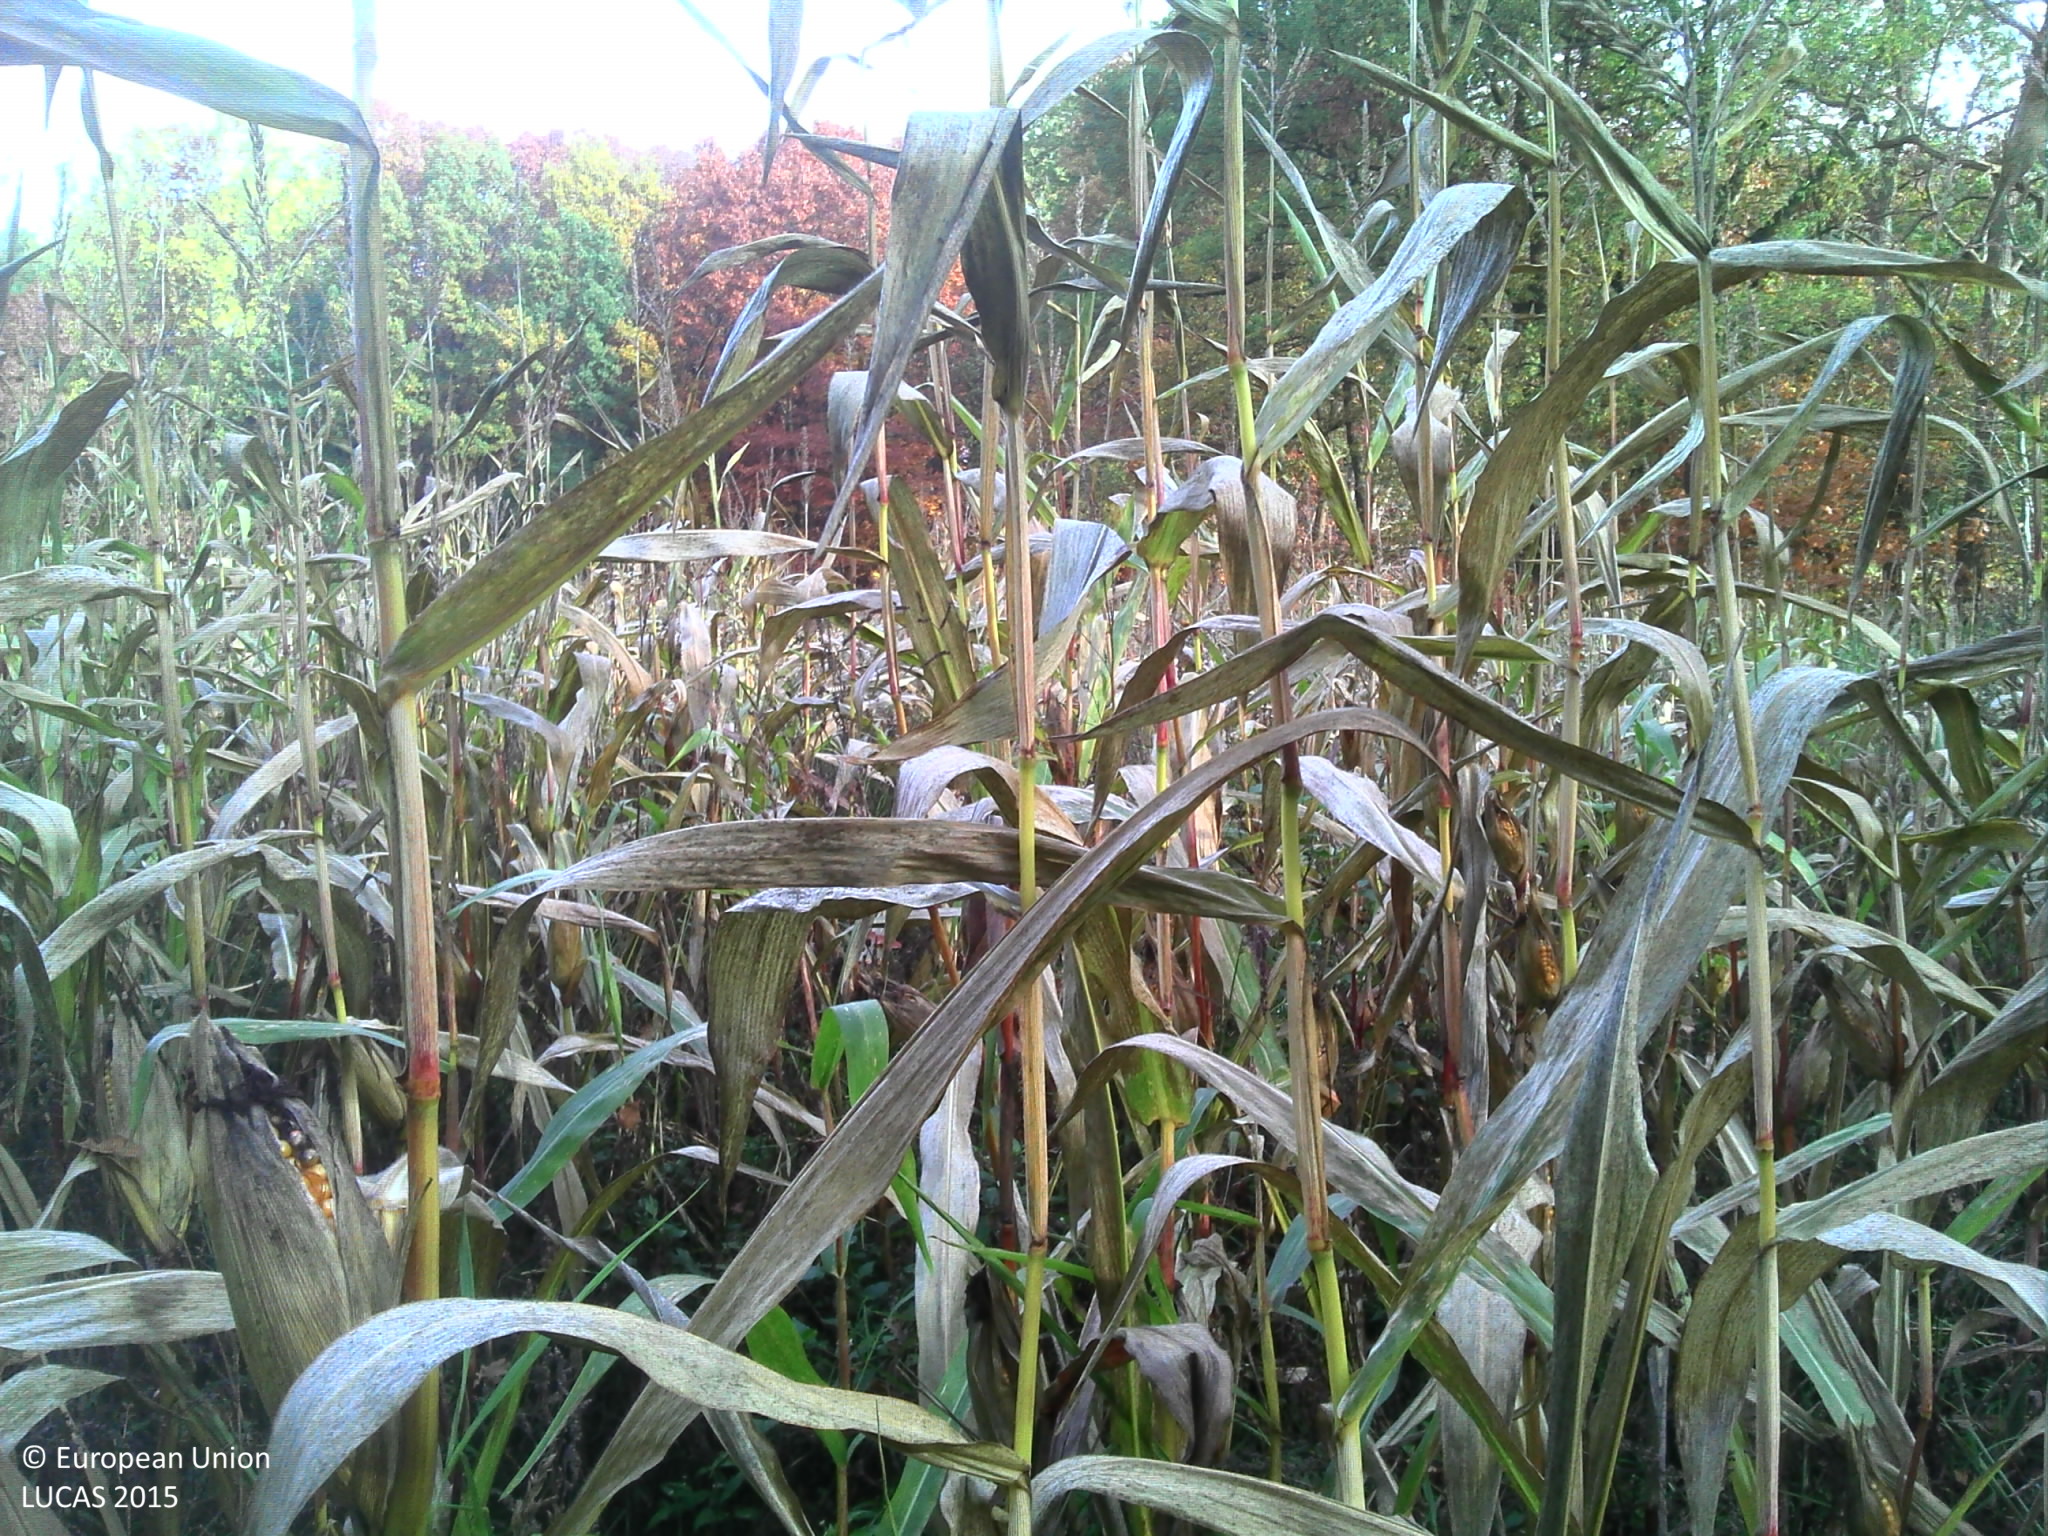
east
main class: Cropland
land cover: Maize
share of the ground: > 75 %
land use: Agriculture (excluding fallow land and kitchen gardens)
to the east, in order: Maize; Fences; Abandoned hedges; Tracks; Broadleaved woodland; Fences; Ditches and canals; Maize
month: October
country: BE
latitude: 51.0351
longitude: 5.1346
